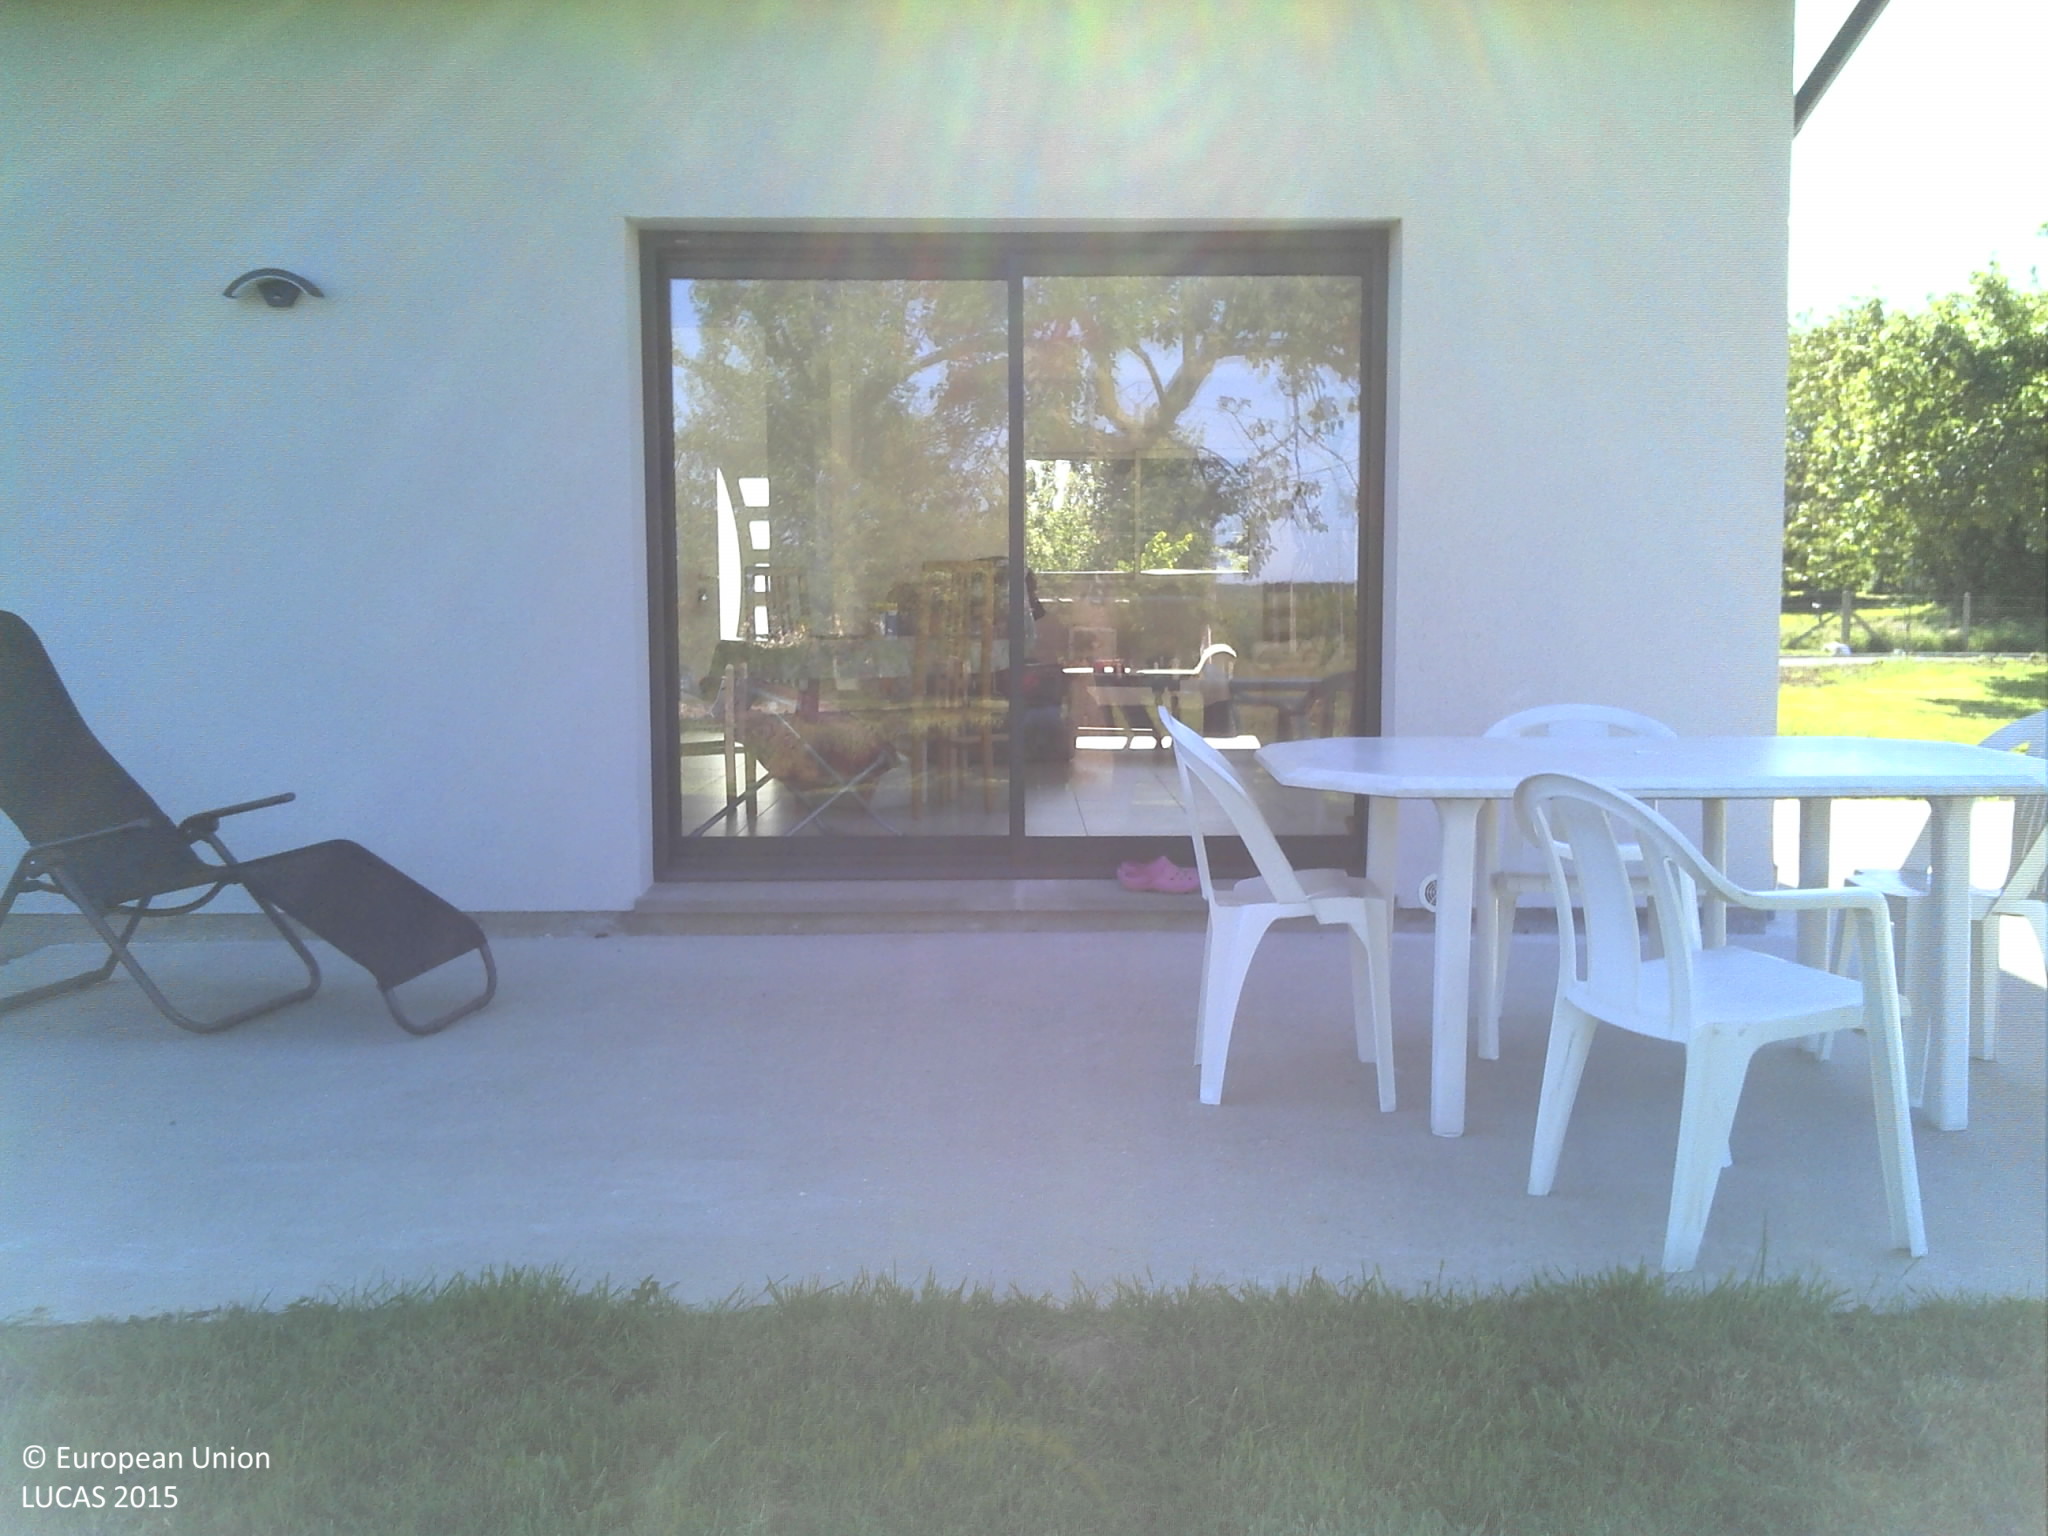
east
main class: Grassland
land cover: Grassland with sparse tree/shrub cover
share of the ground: > 75 %
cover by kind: herbaceous plants 95 %, broadleaved forest trees 5 %
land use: Residential
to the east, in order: Grassland with sparse tree/shrub cover; Artificial constructions in urban areas
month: June
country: FR
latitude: 49.5833
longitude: 1.1125
